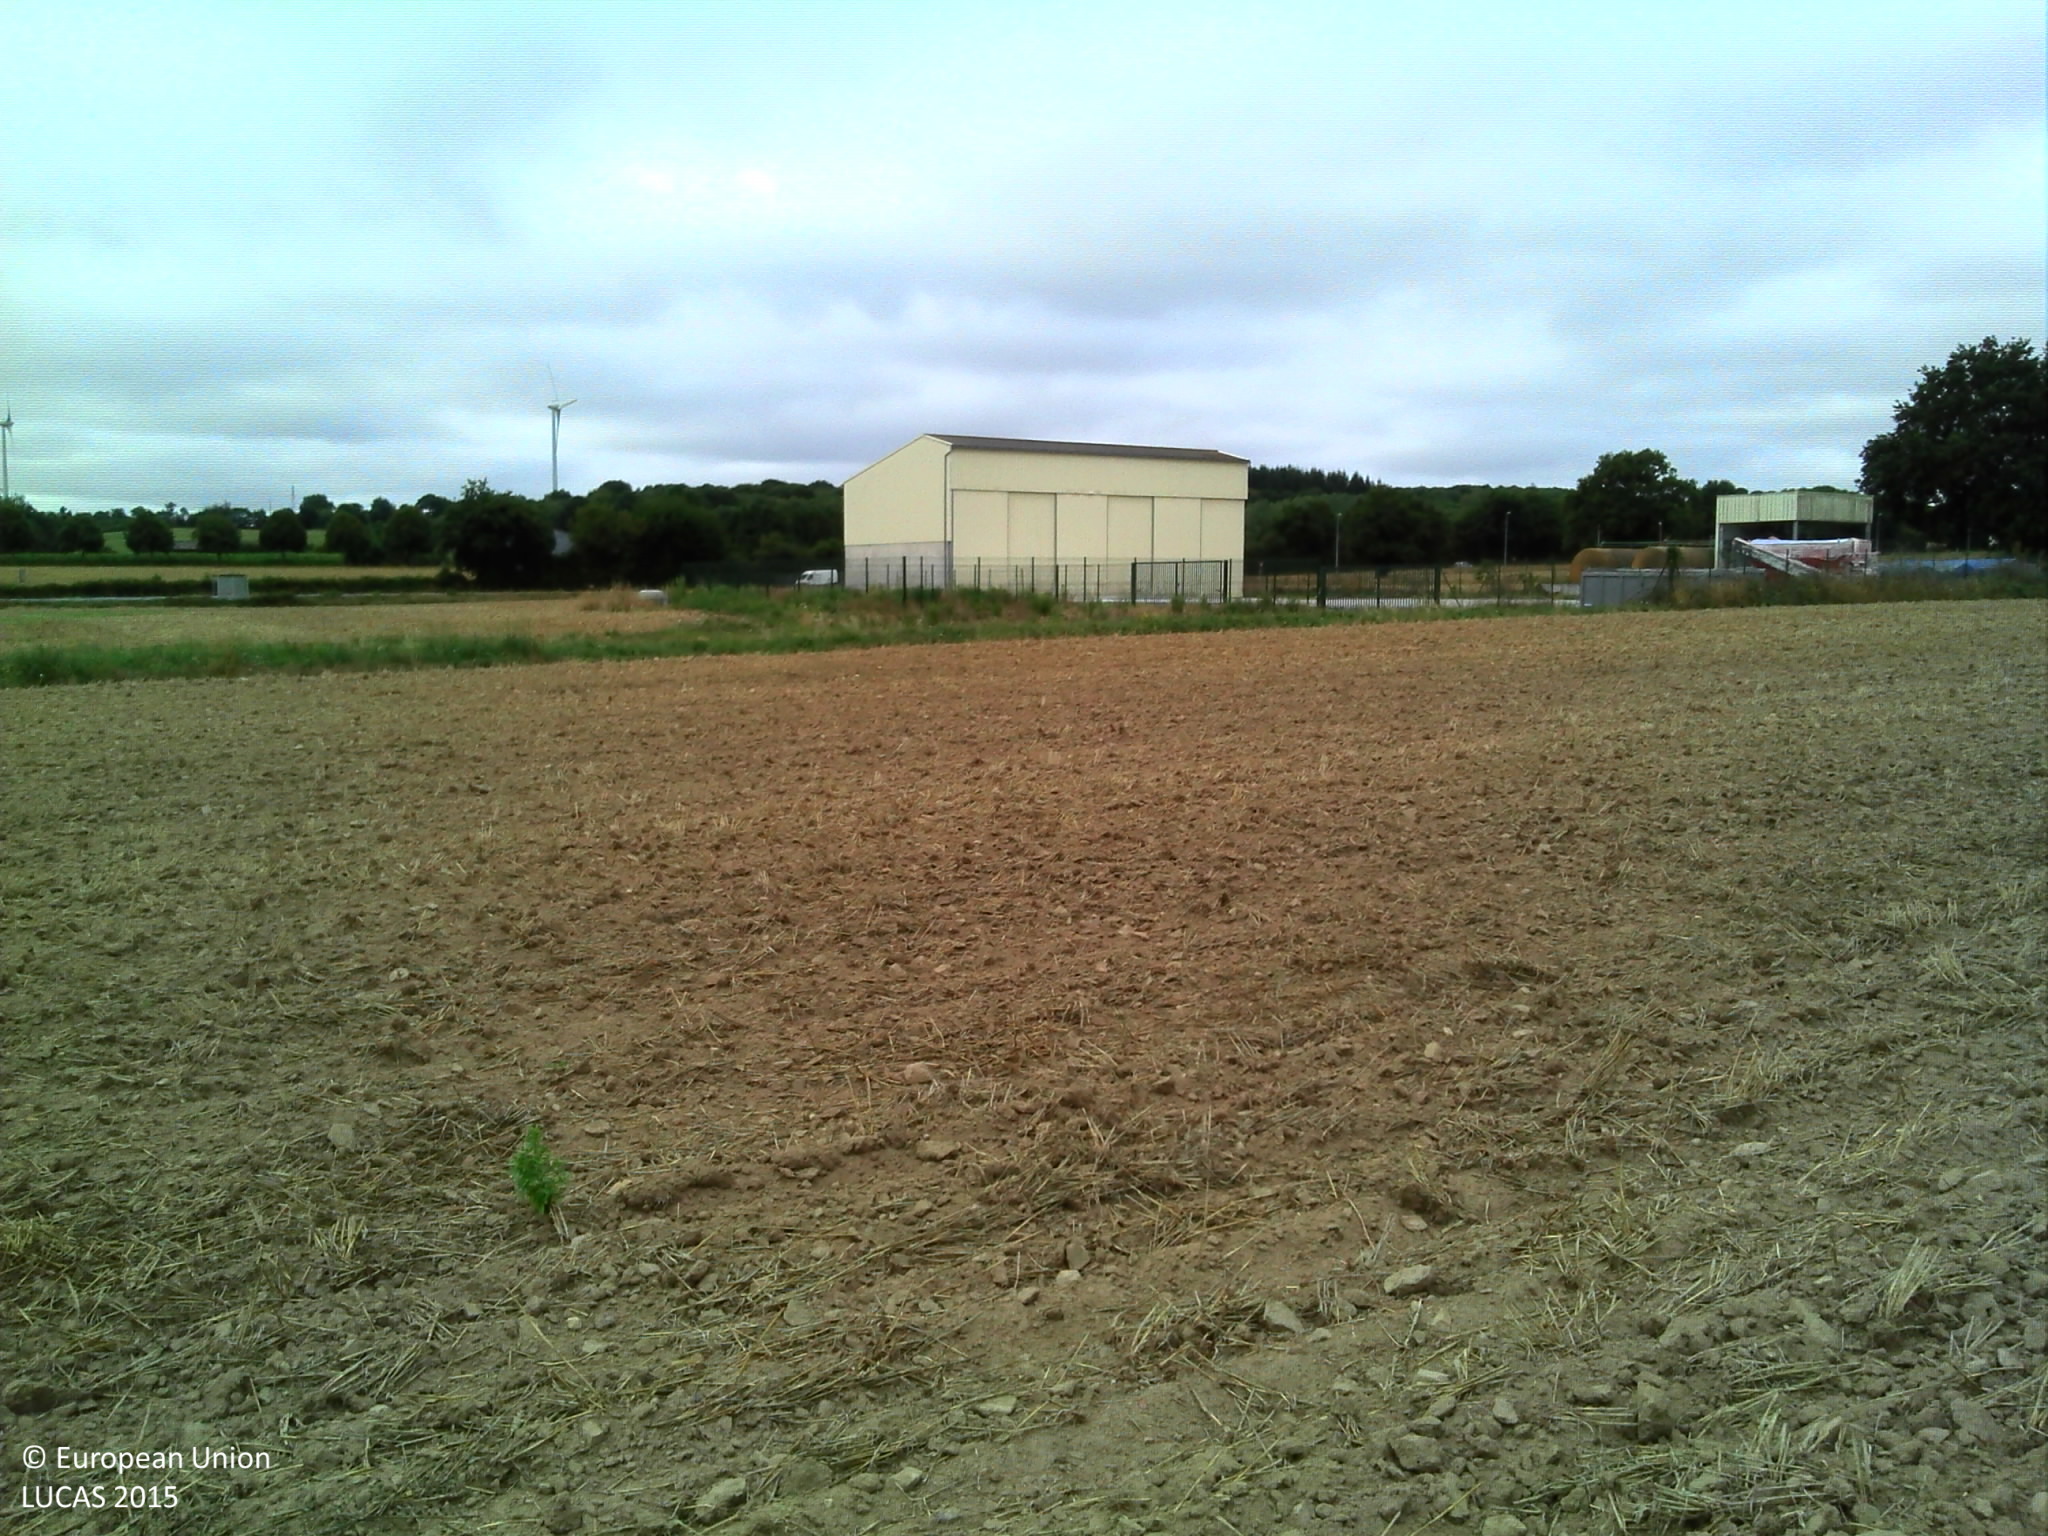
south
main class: Cropland
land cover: Common wheat
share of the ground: < 10 %
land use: Agriculture (excluding fallow land and kitchen gardens)
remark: Tilled/Sowed
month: August
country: FR
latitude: 47.7277
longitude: -1.3346
